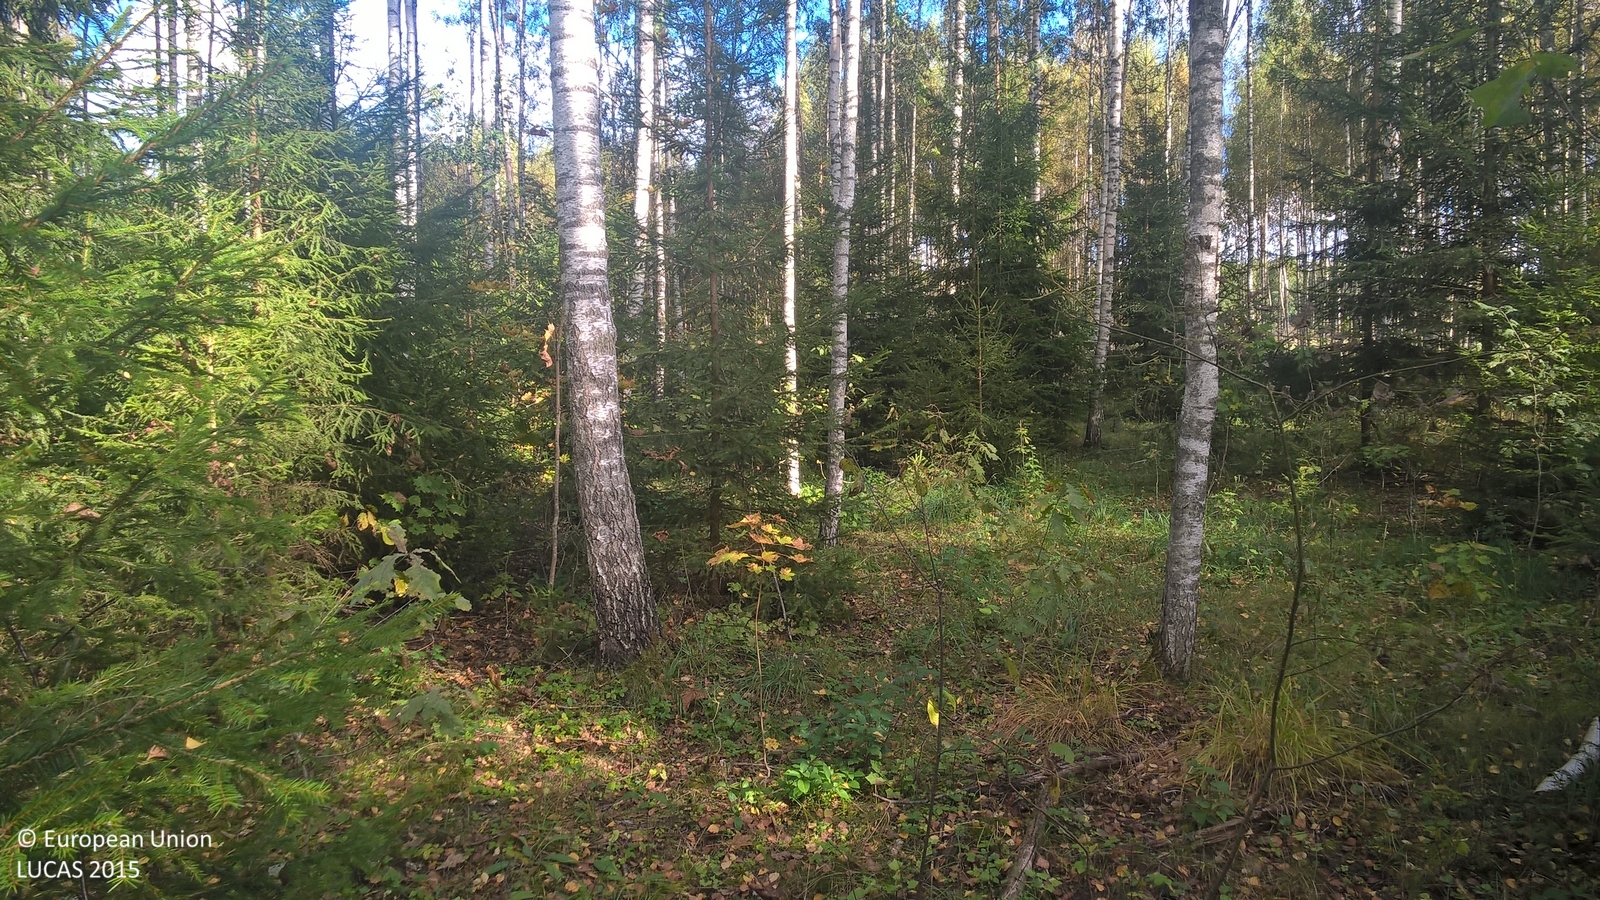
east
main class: Woodland
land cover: Spruce dominated mixed woodland
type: hemiboreal forest and nemoral coniferous forest and mixed broadleaved-coniferous forest
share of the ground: > 75 %
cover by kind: coniferous forest trees 40 %, broadleaved forest trees 40 %, herbaceous plants 10 %, lichens and mosses 10 %
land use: Forestry
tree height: > 5 m
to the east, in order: Spruce dominated mixed woodland; Tracks; Broadleaved woodland; Grassland without tree/shrub cover; Abandoned hedges; Paved roads, cycling and walking lanes; Grass margins; Other bare soil
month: September
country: LV
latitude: 57.7989
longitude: 25.5775
